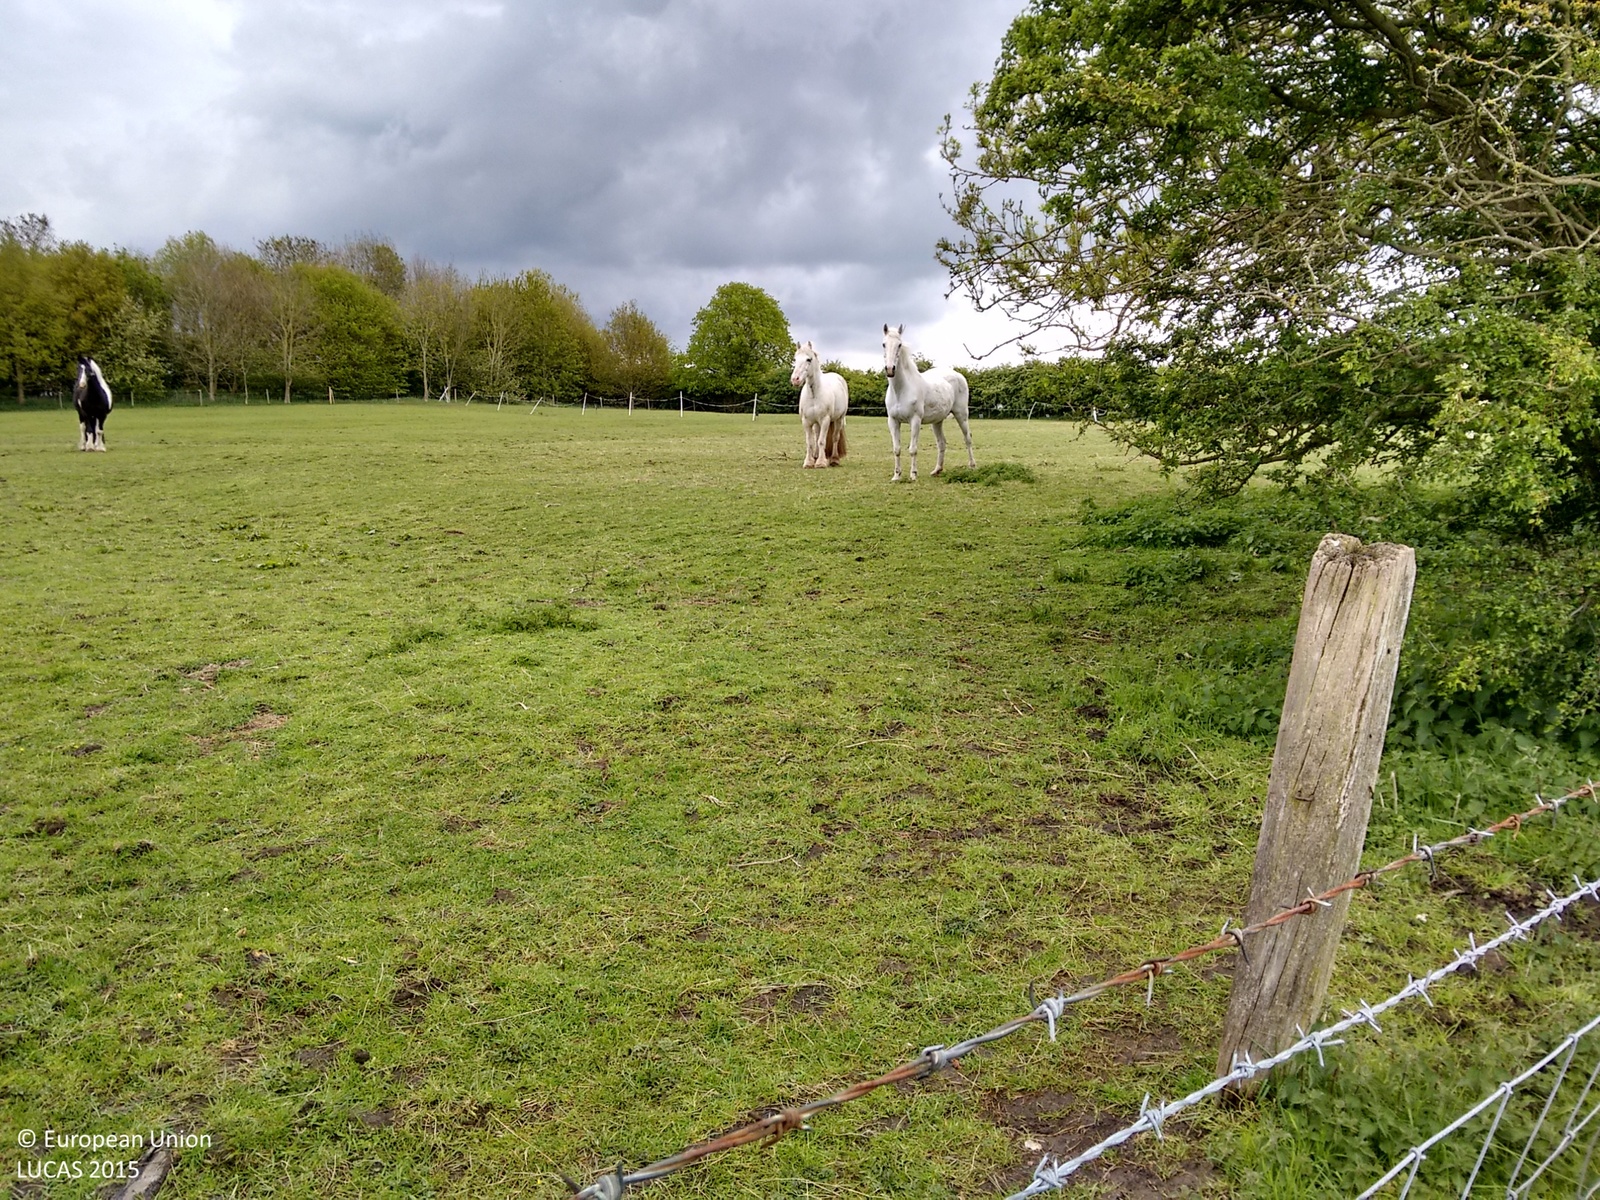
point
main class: Grassland
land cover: Grassland without tree/shrub cover
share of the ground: > 75 %
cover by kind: herbaceous plants 100 %
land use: Agriculture (excluding fallow land and kitchen gardens)
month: May
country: GB
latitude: 53.3657
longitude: -0.2384
